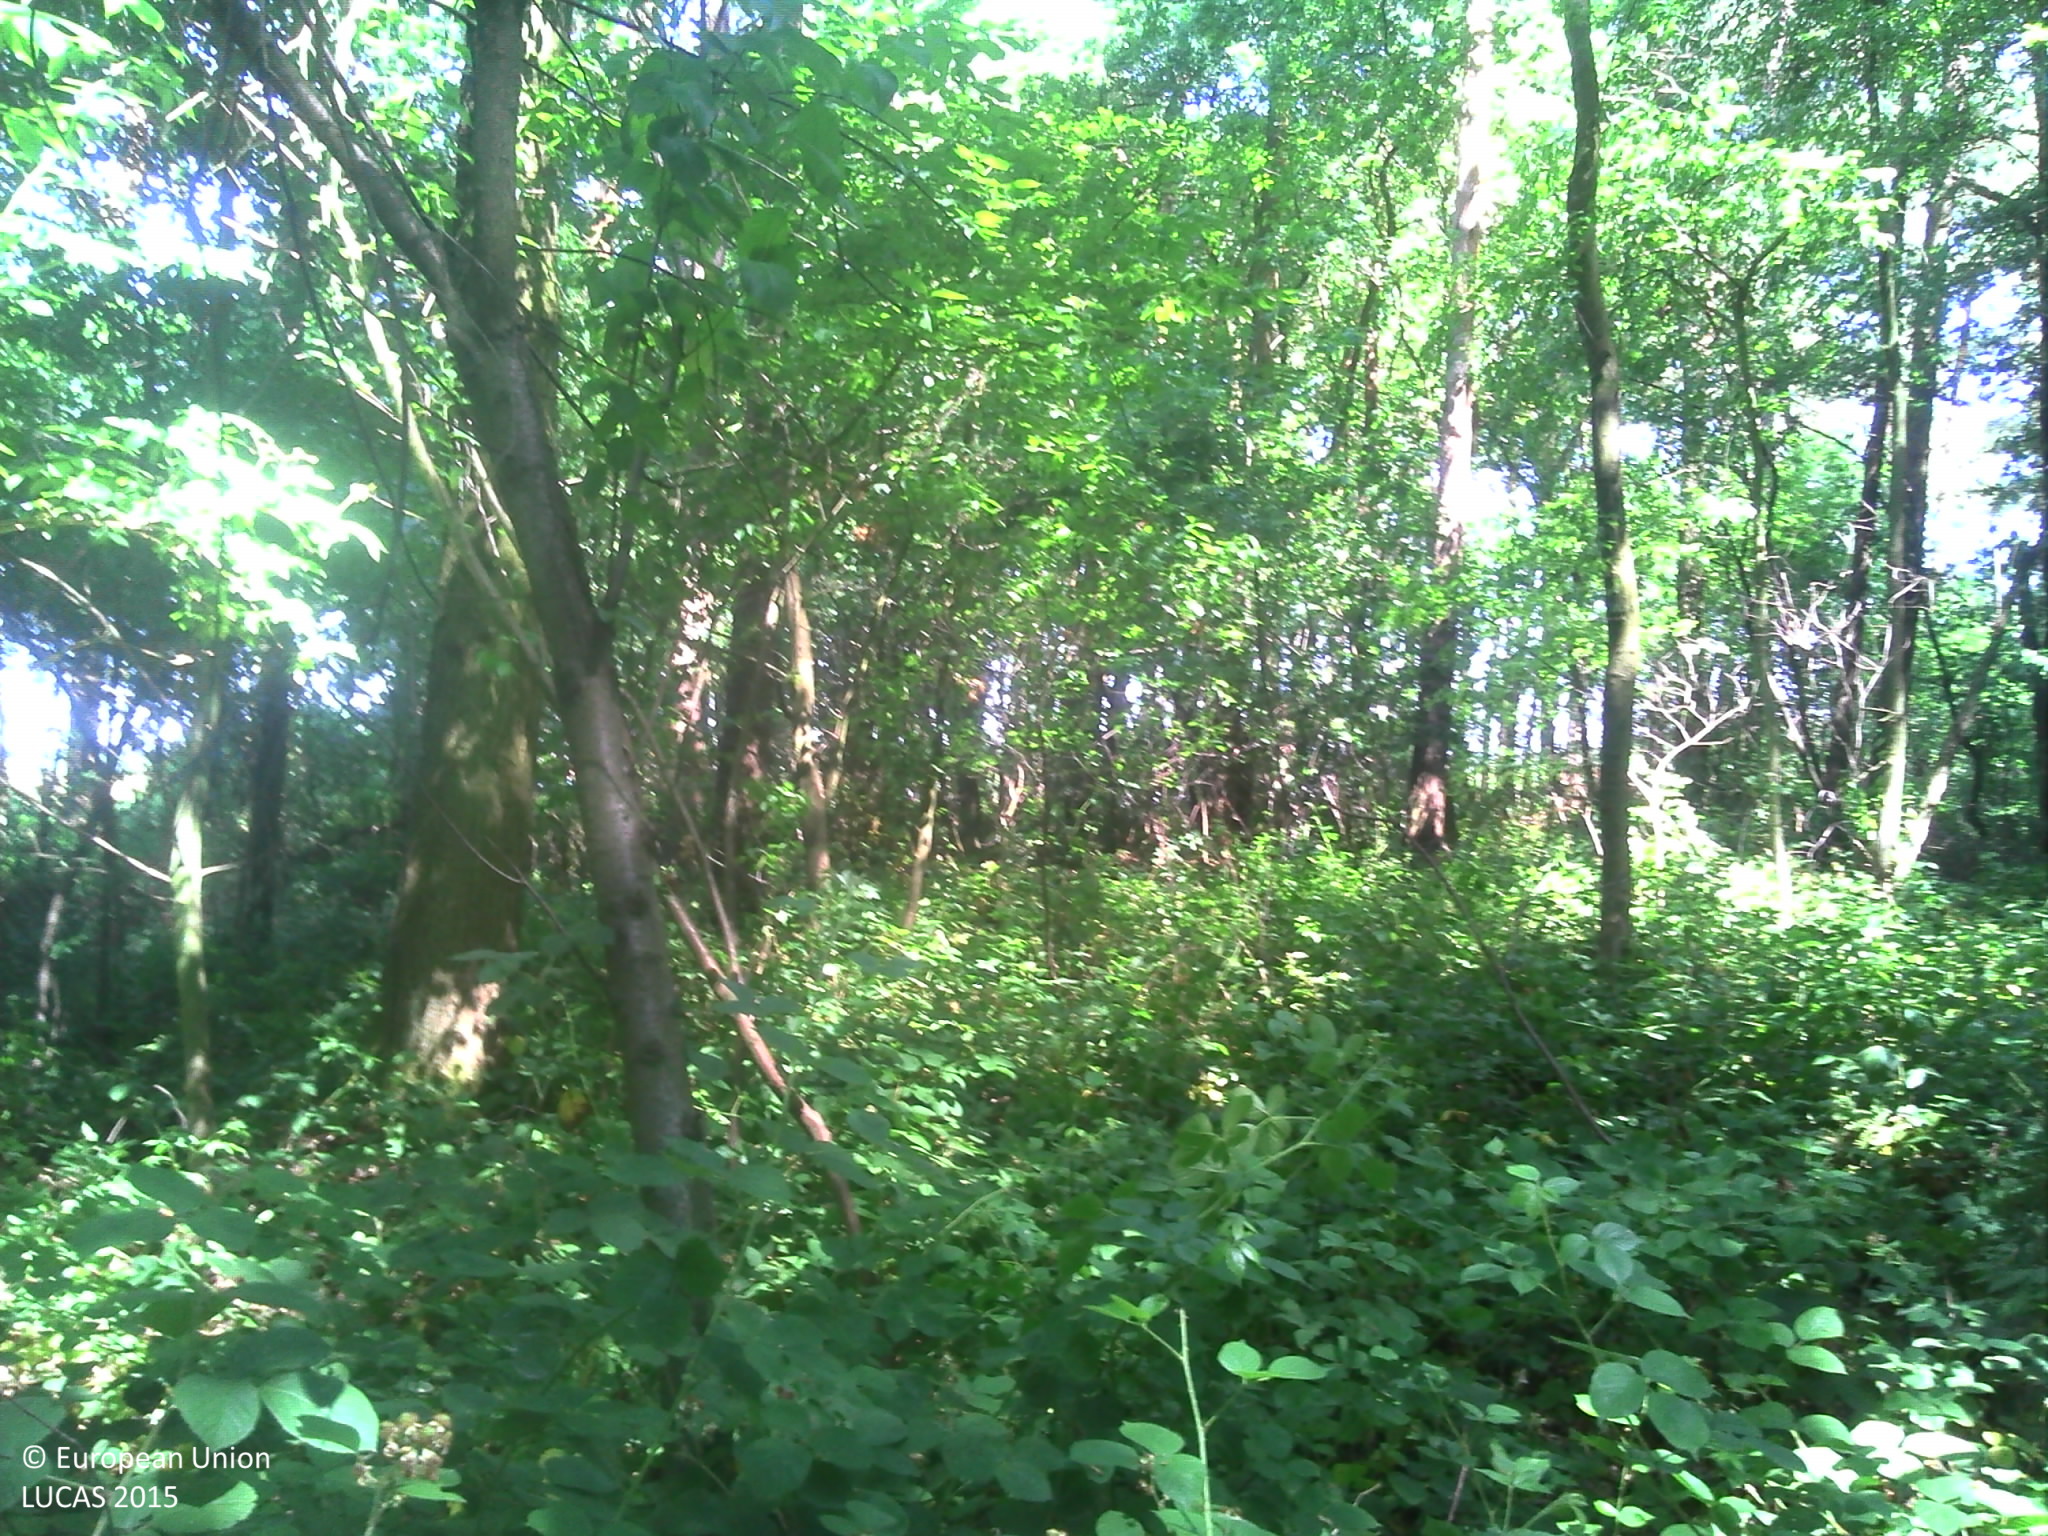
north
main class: Woodland
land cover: Broadleaved woodland
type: acidophilous oak and oak-birch forest
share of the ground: > 75 %
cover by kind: broadleaved forest trees 85 %, shrubs 10 %, coniferous forest trees 5 %
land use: Forestry
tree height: > 5 m
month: July
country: BE
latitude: 50.8166
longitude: 4.6736
